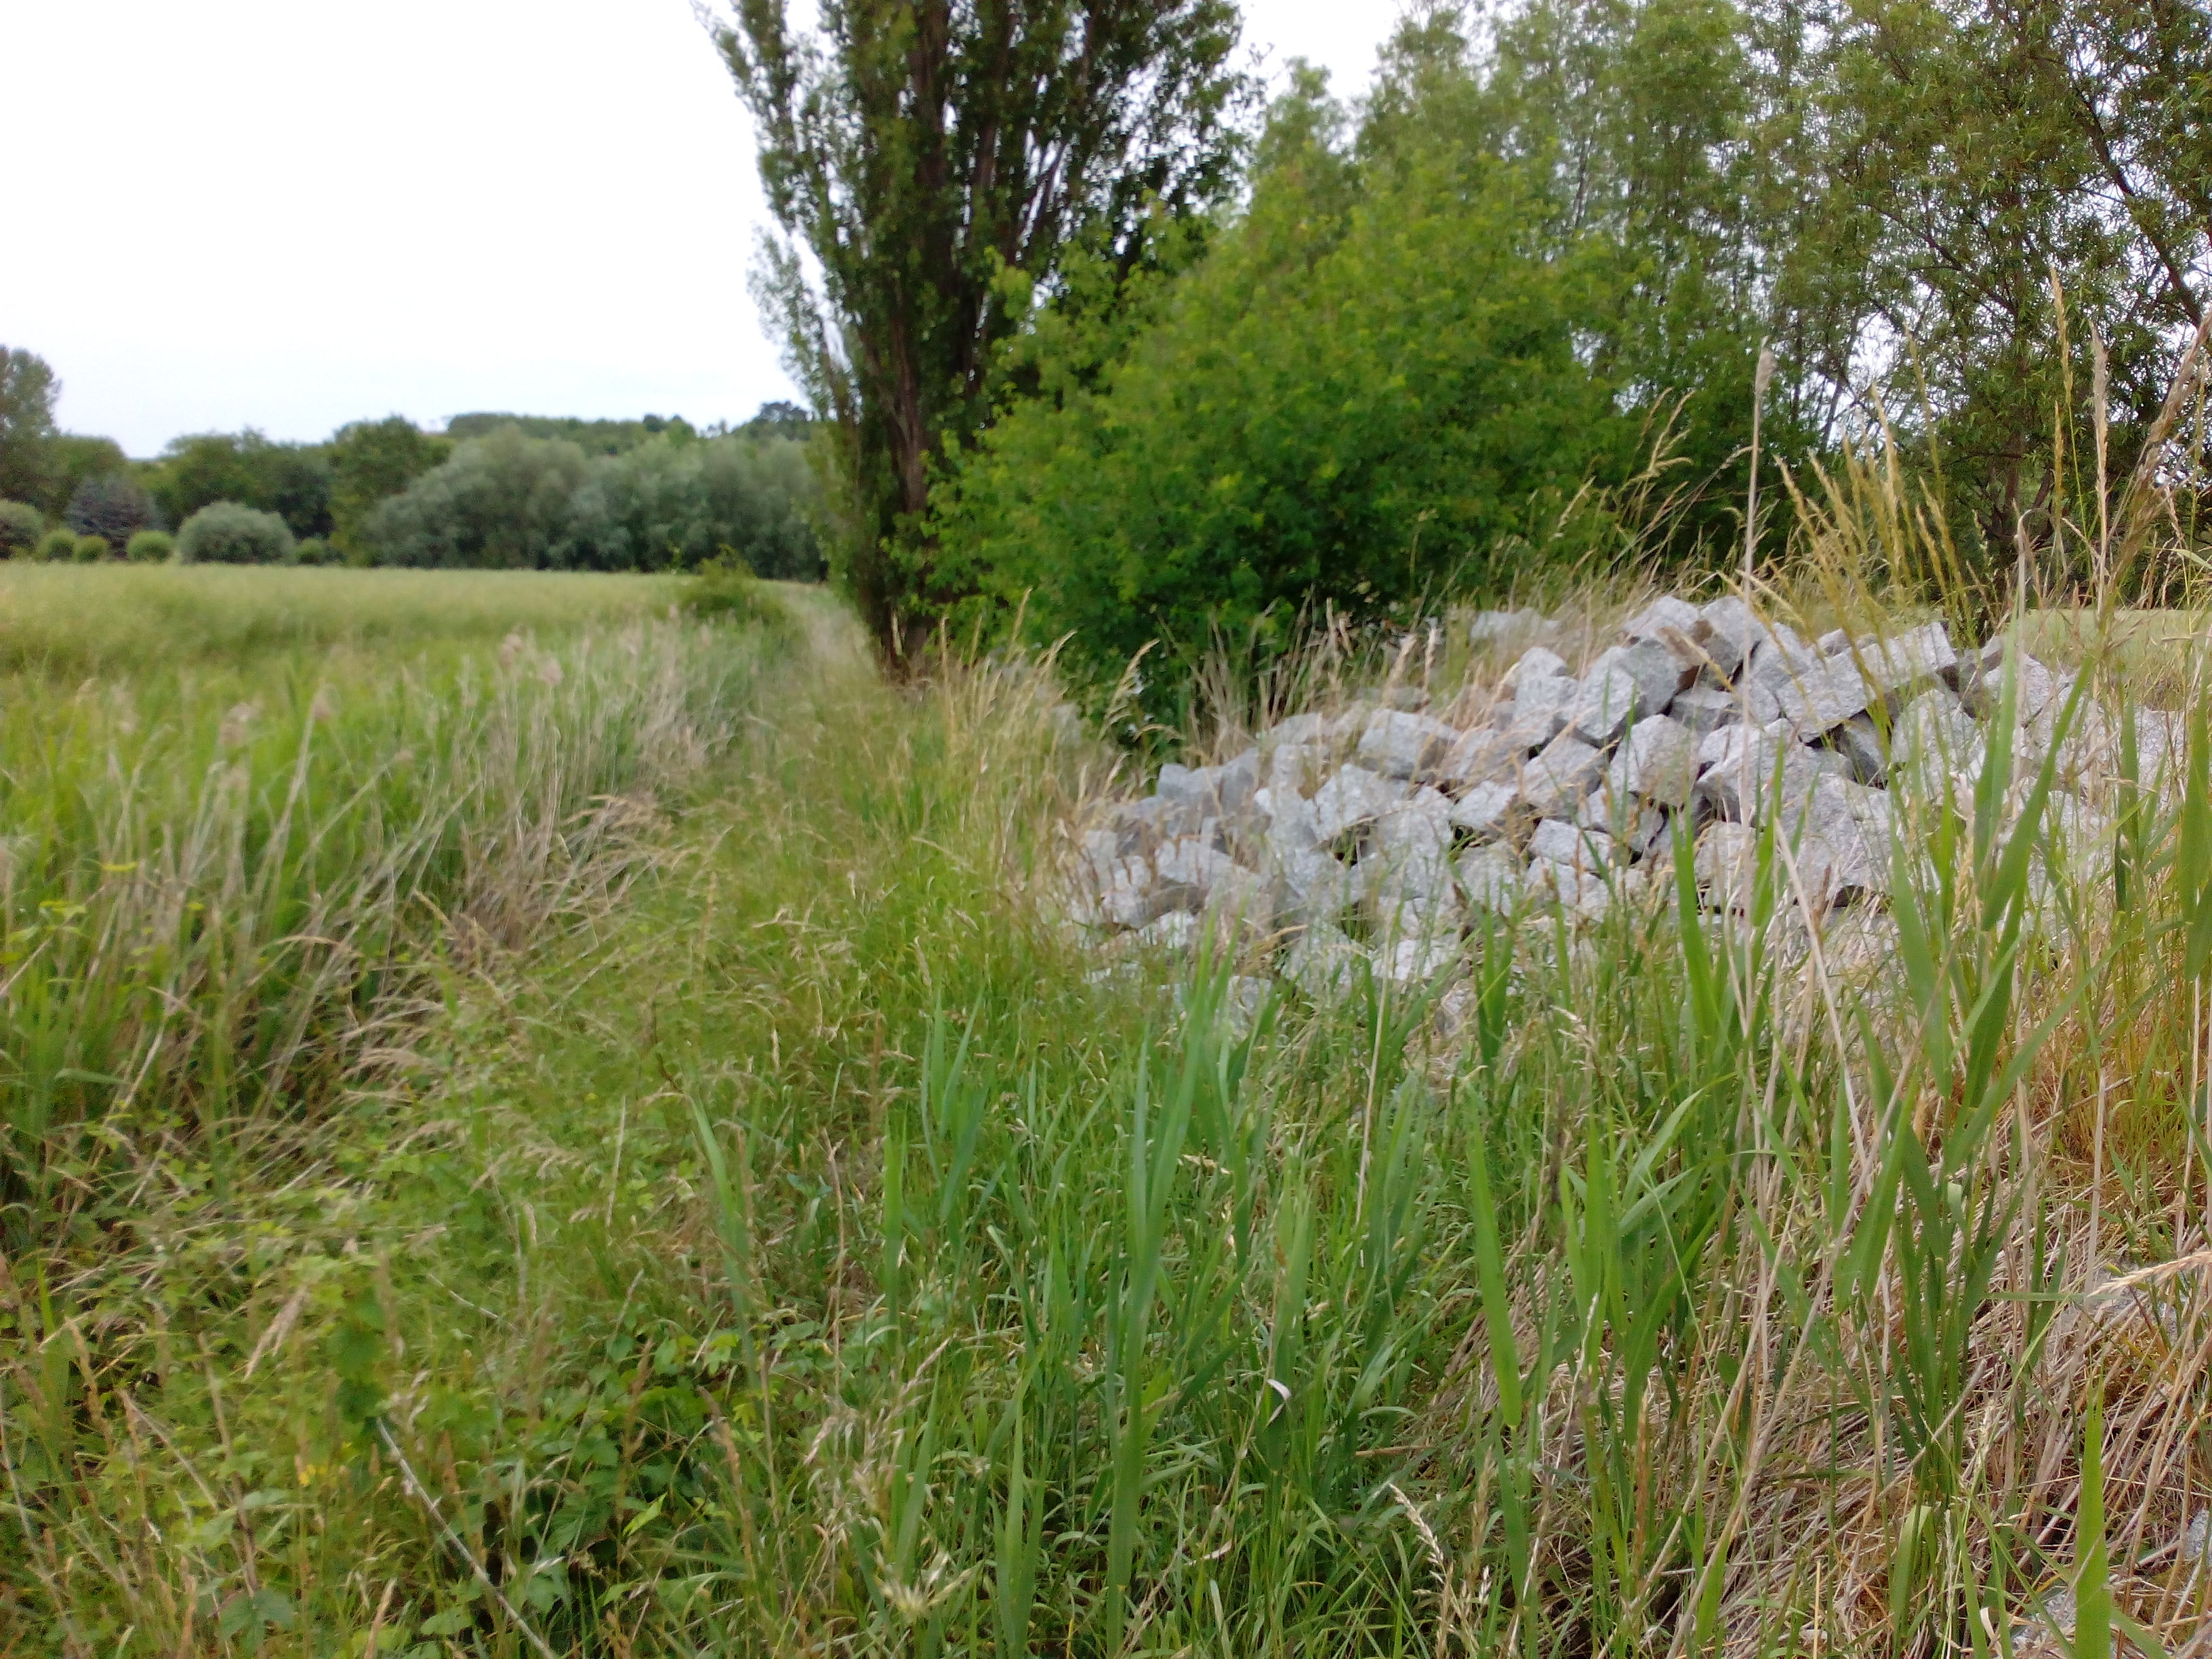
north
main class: Cropland
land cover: Rape and turnip rape
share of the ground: > 75 %
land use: Agriculture (excluding fallow land and kitchen gardens)
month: June
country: DE
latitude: 51.2226
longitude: 11.0163
